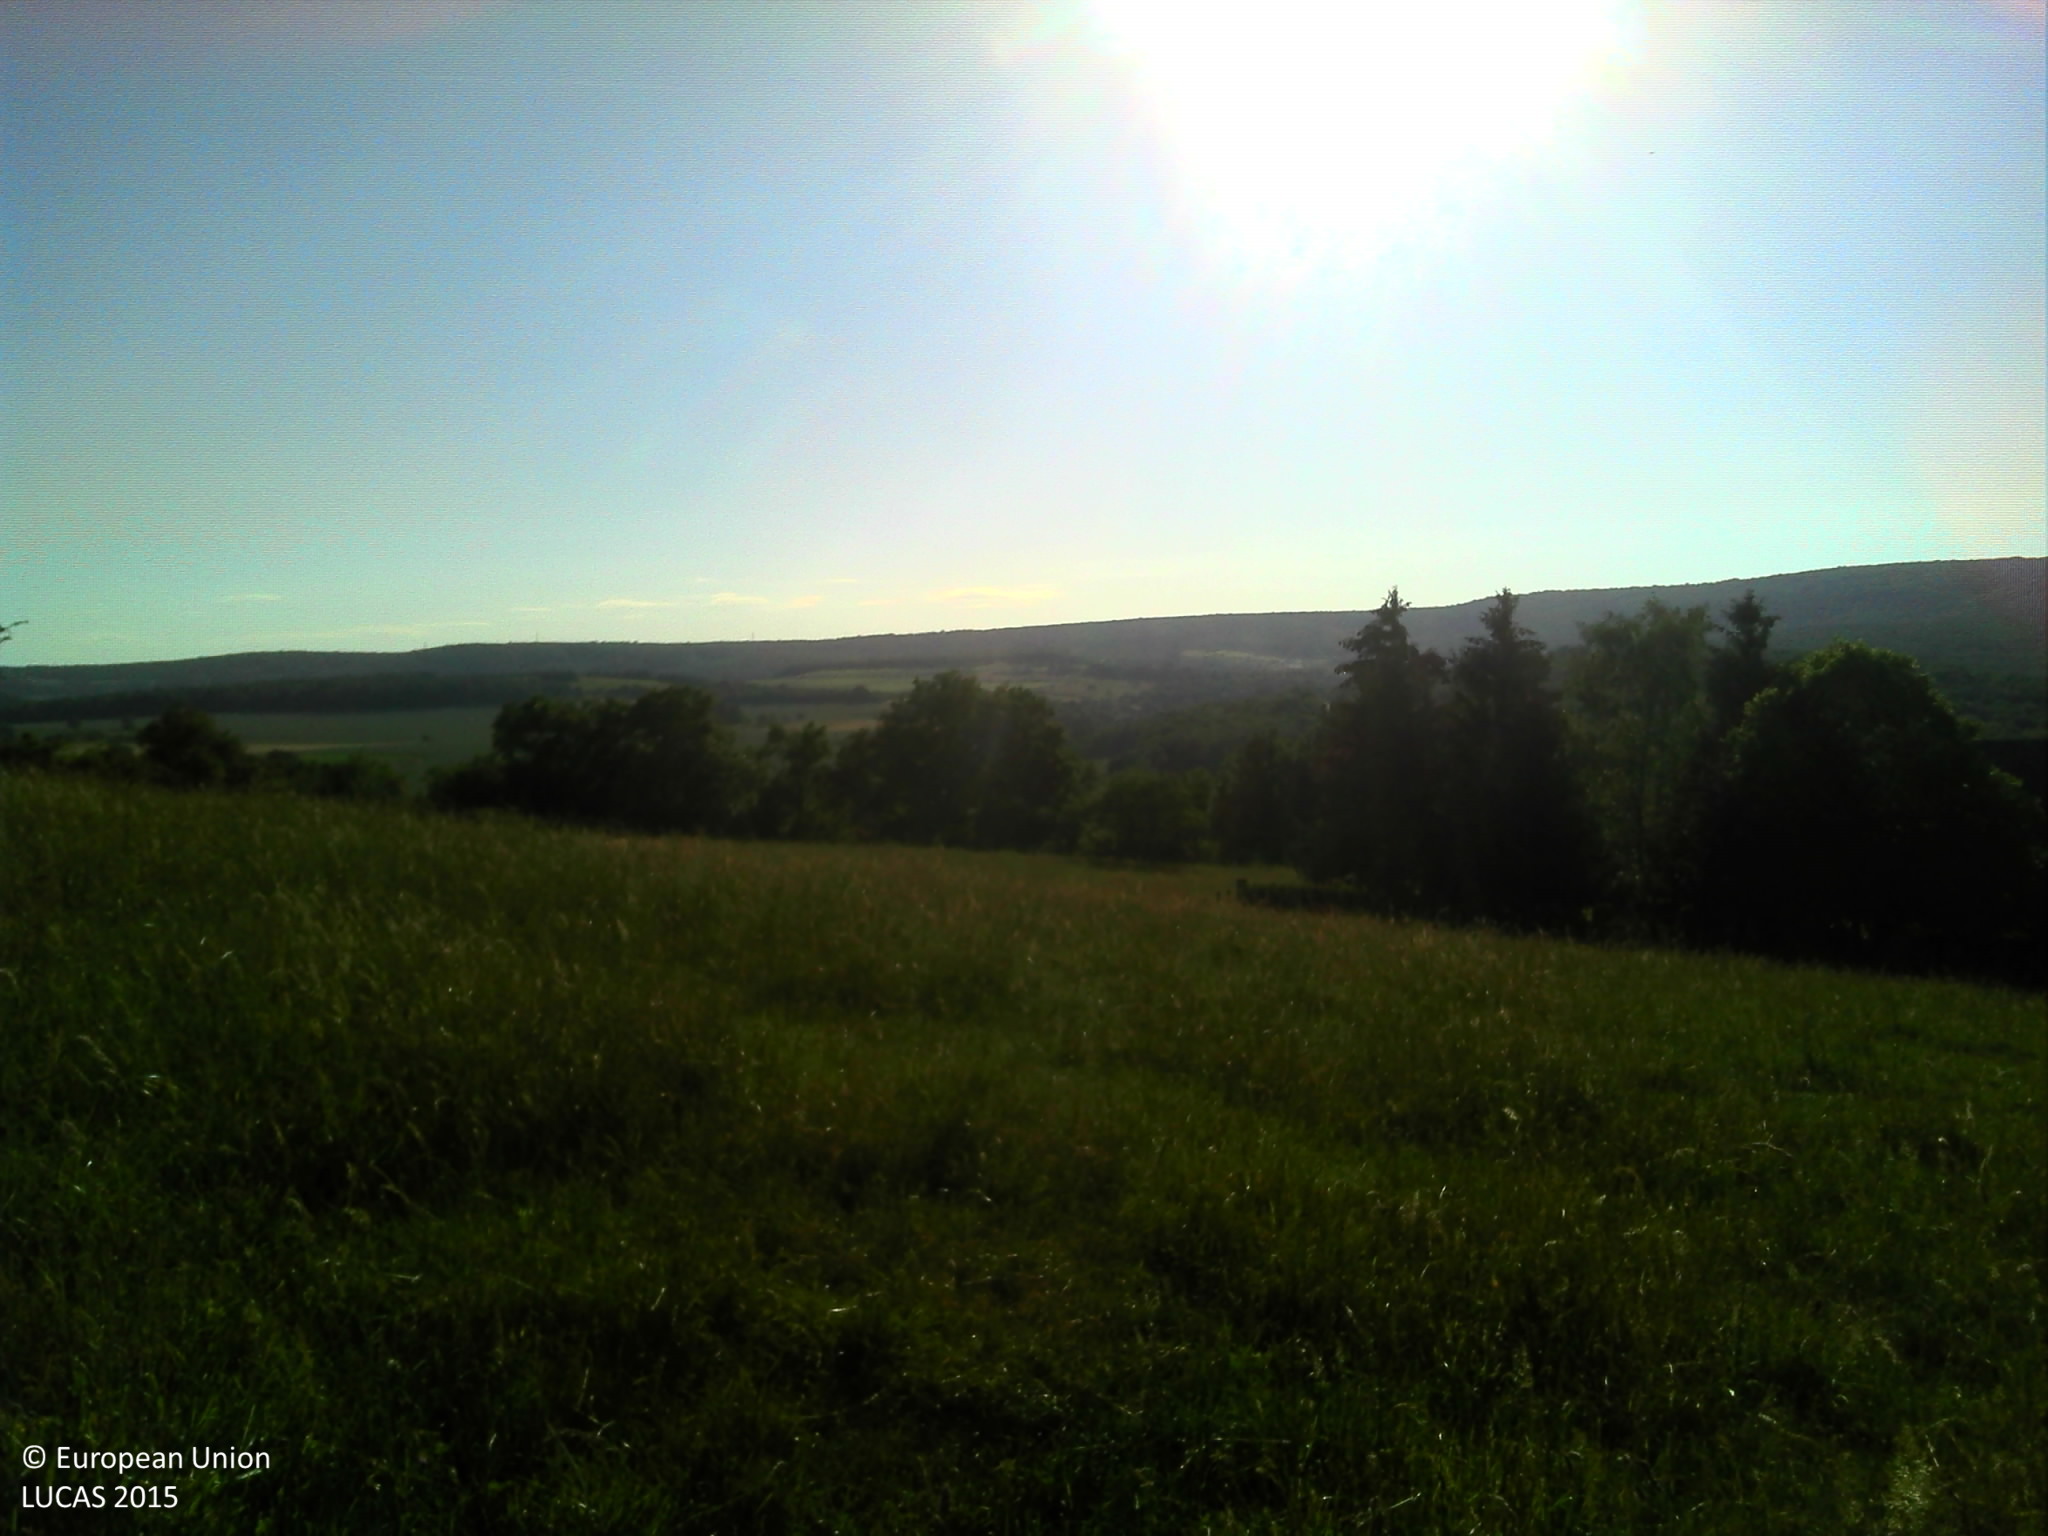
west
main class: Grassland
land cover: Grassland without tree/shrub cover
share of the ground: > 75 %
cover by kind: herbaceous plants 100 %
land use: Agriculture (excluding fallow land and kitchen gardens)
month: June
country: FR
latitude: 46.5712
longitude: 4.8742
